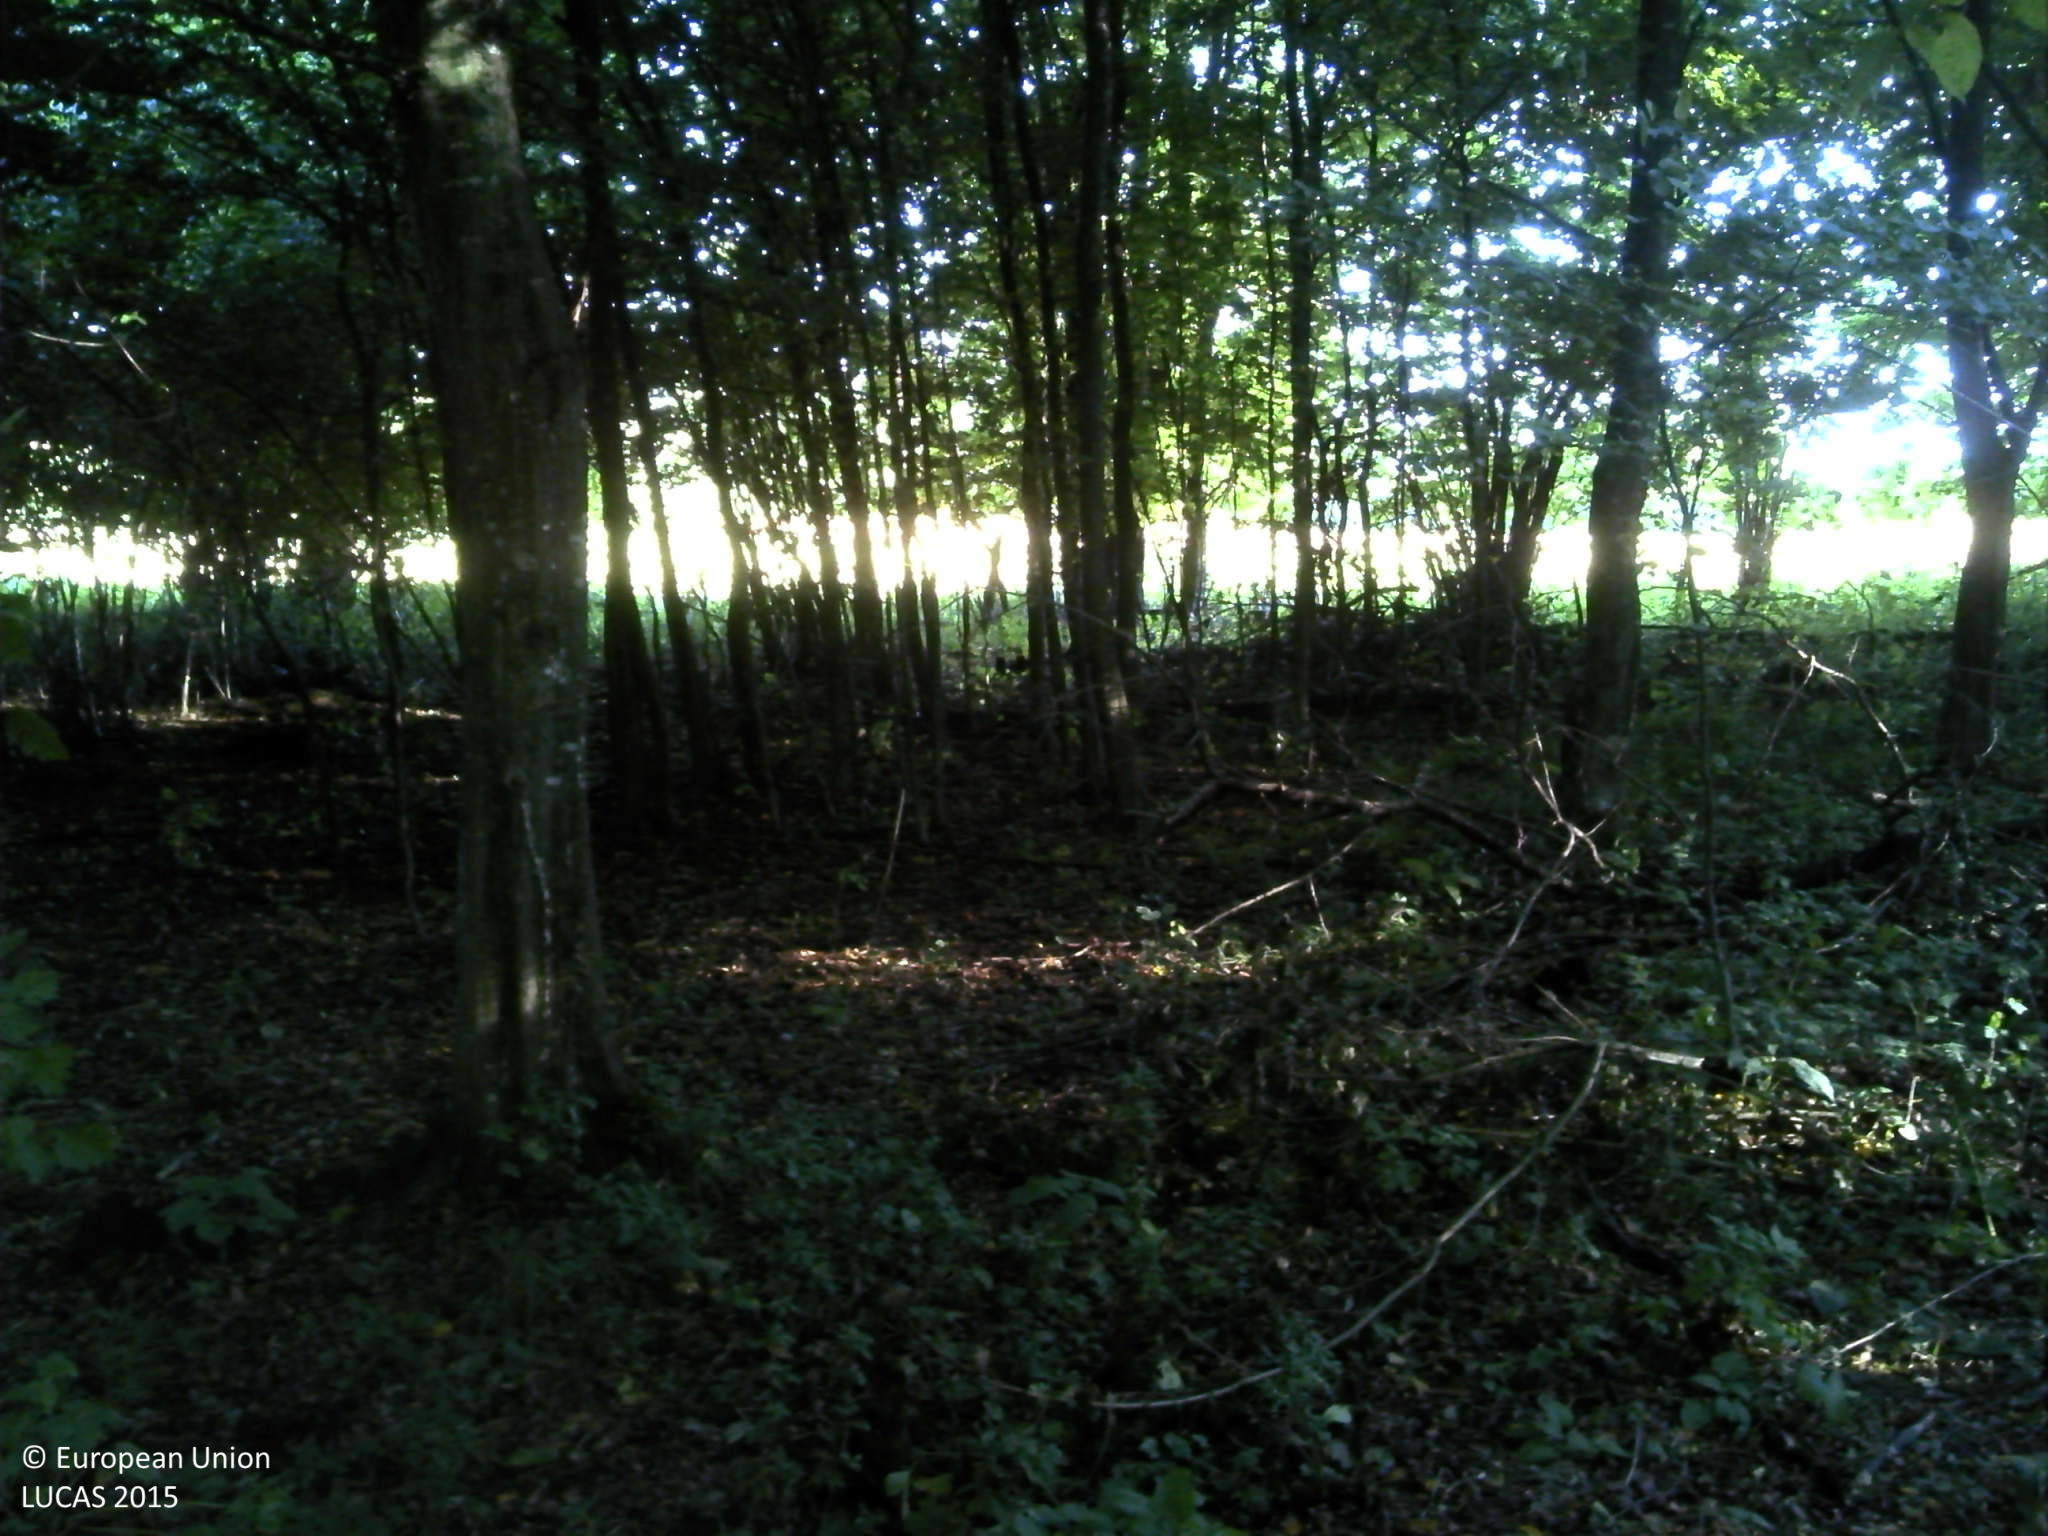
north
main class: Woodland
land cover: Broadleaved woodland
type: acidophilous oak and oak-birch forest
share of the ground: > 75 %
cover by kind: broadleaved forest trees 90 %, shrubs 5 %, herbaceous plants 5 %
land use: Forestry
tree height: > 5 m
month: July
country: HR
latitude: 45.9915
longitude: 16.7785
